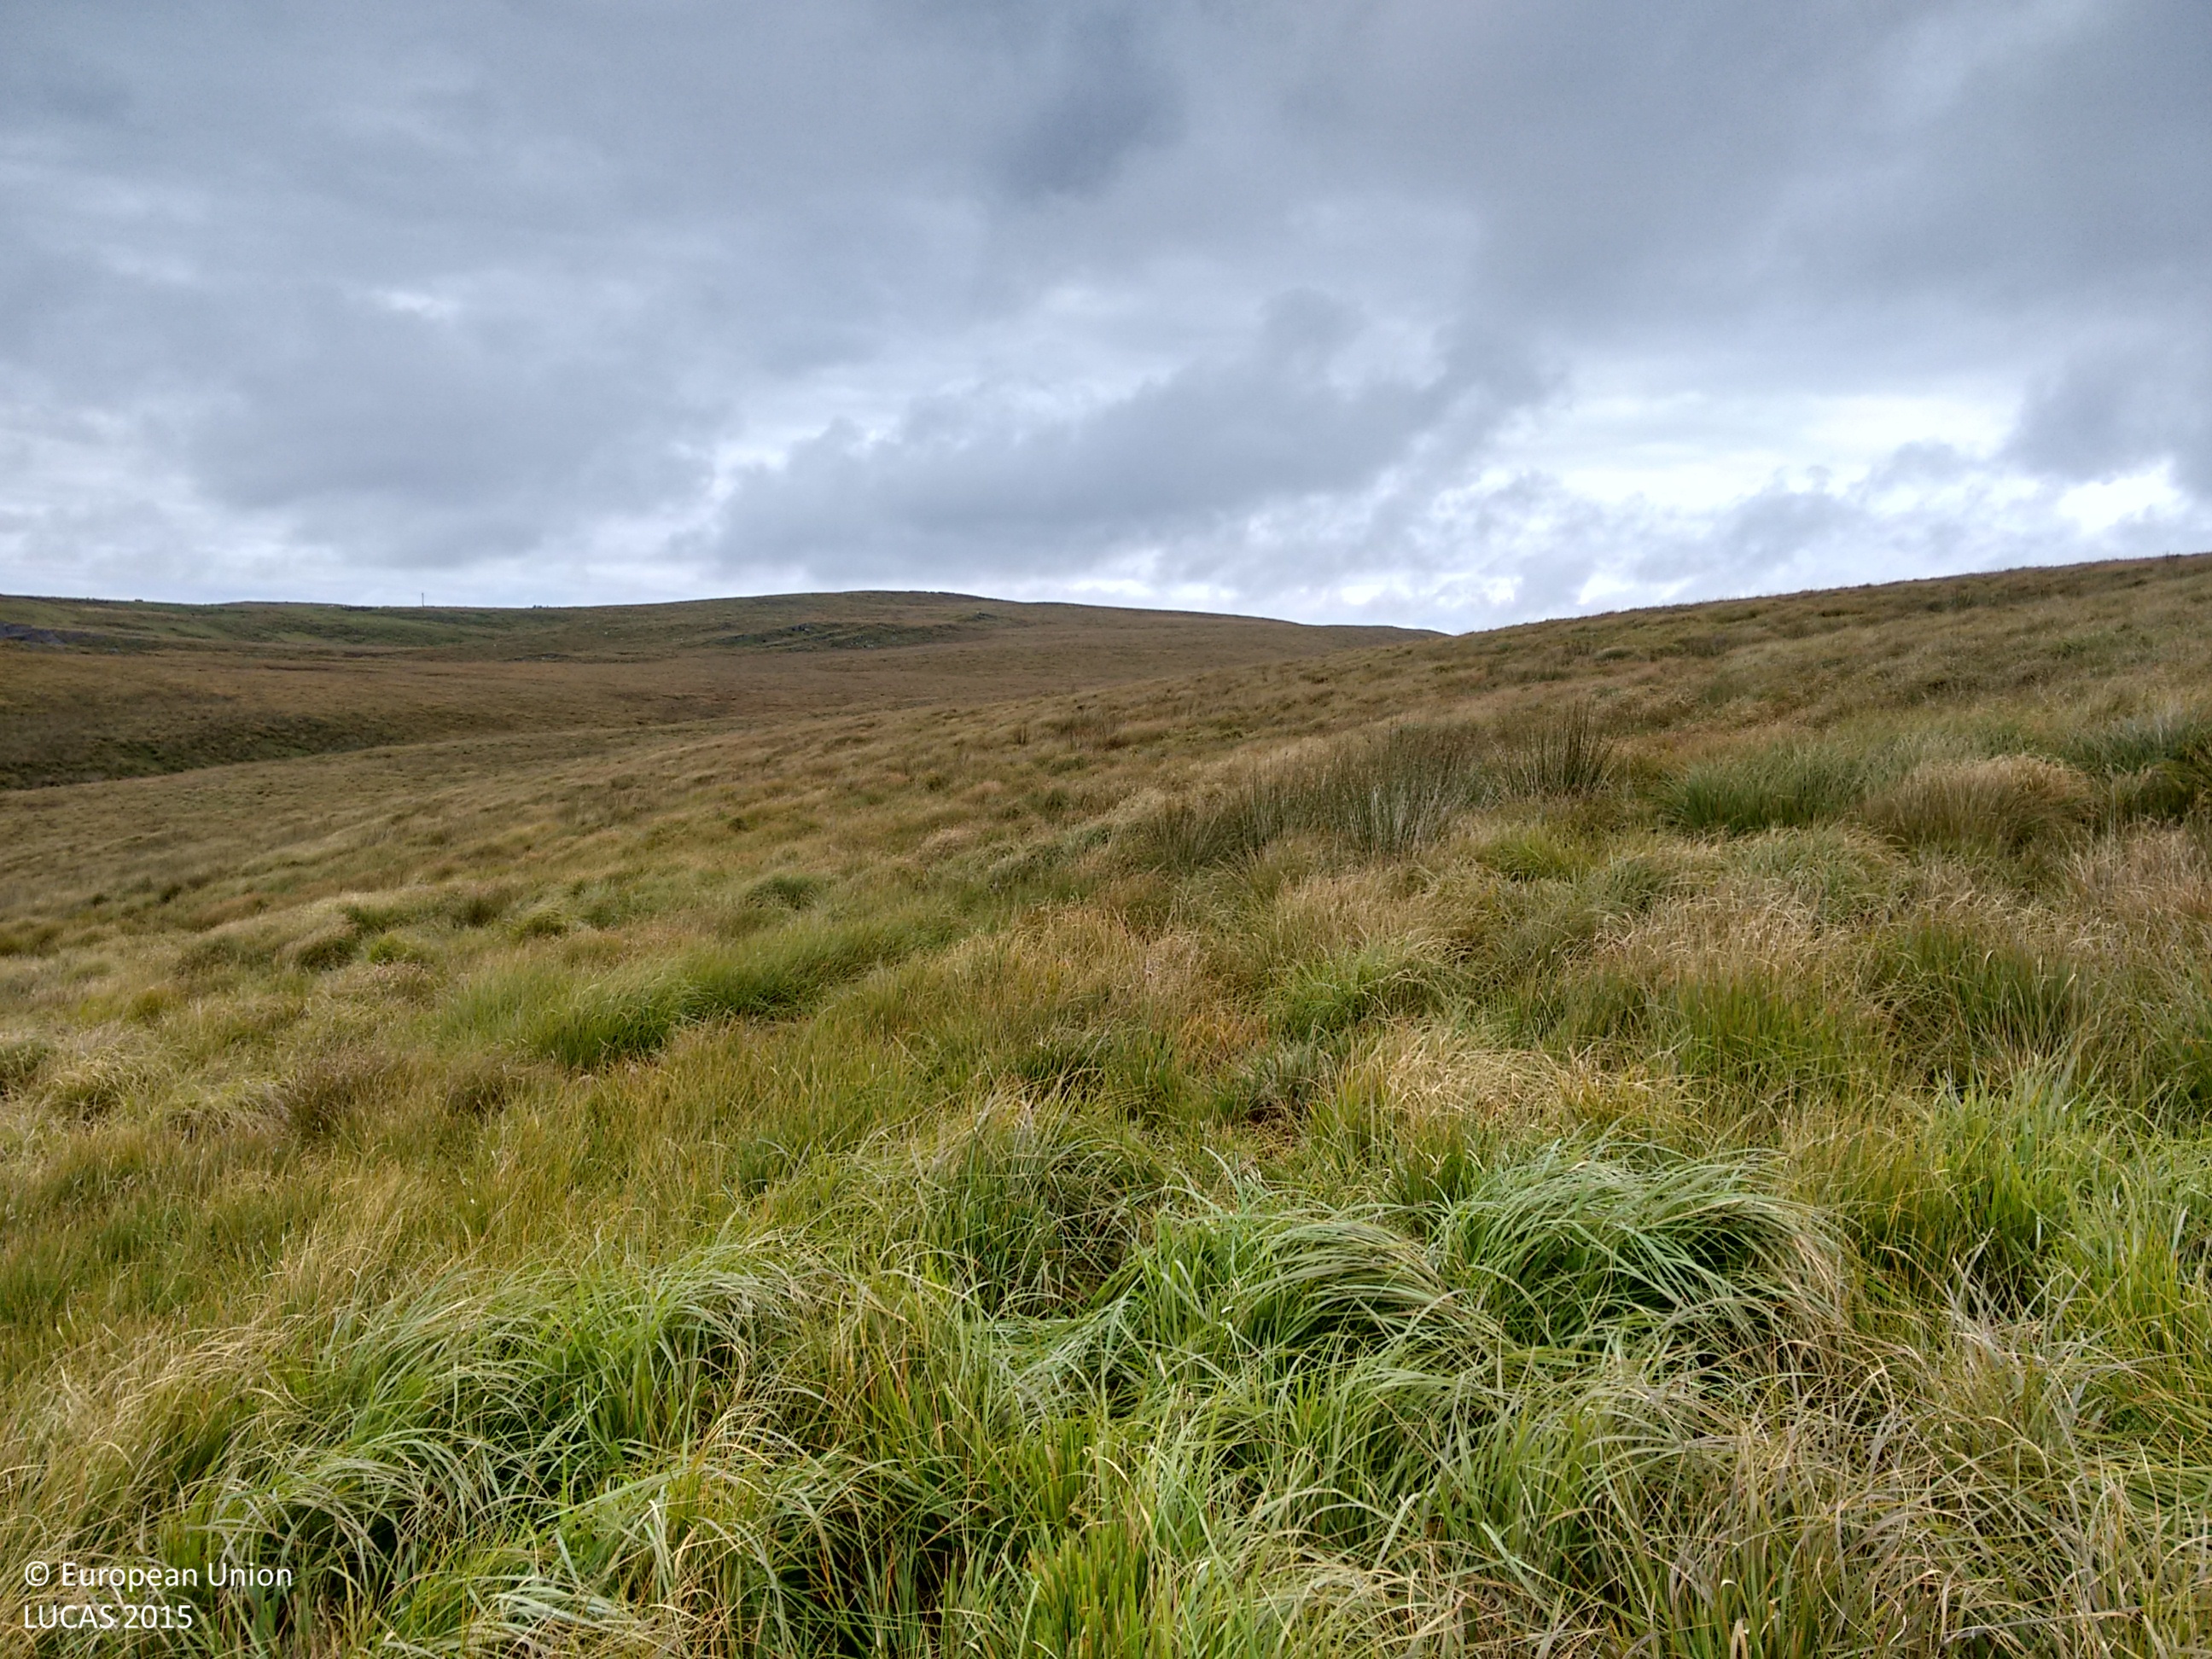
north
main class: Grassland
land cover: Grassland without tree/shrub cover
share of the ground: > 75 %
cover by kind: herbaceous plants 100 %
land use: Agriculture (excluding fallow land and kitchen gardens)
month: September
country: GB
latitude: 52.2049
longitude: -3.8015
